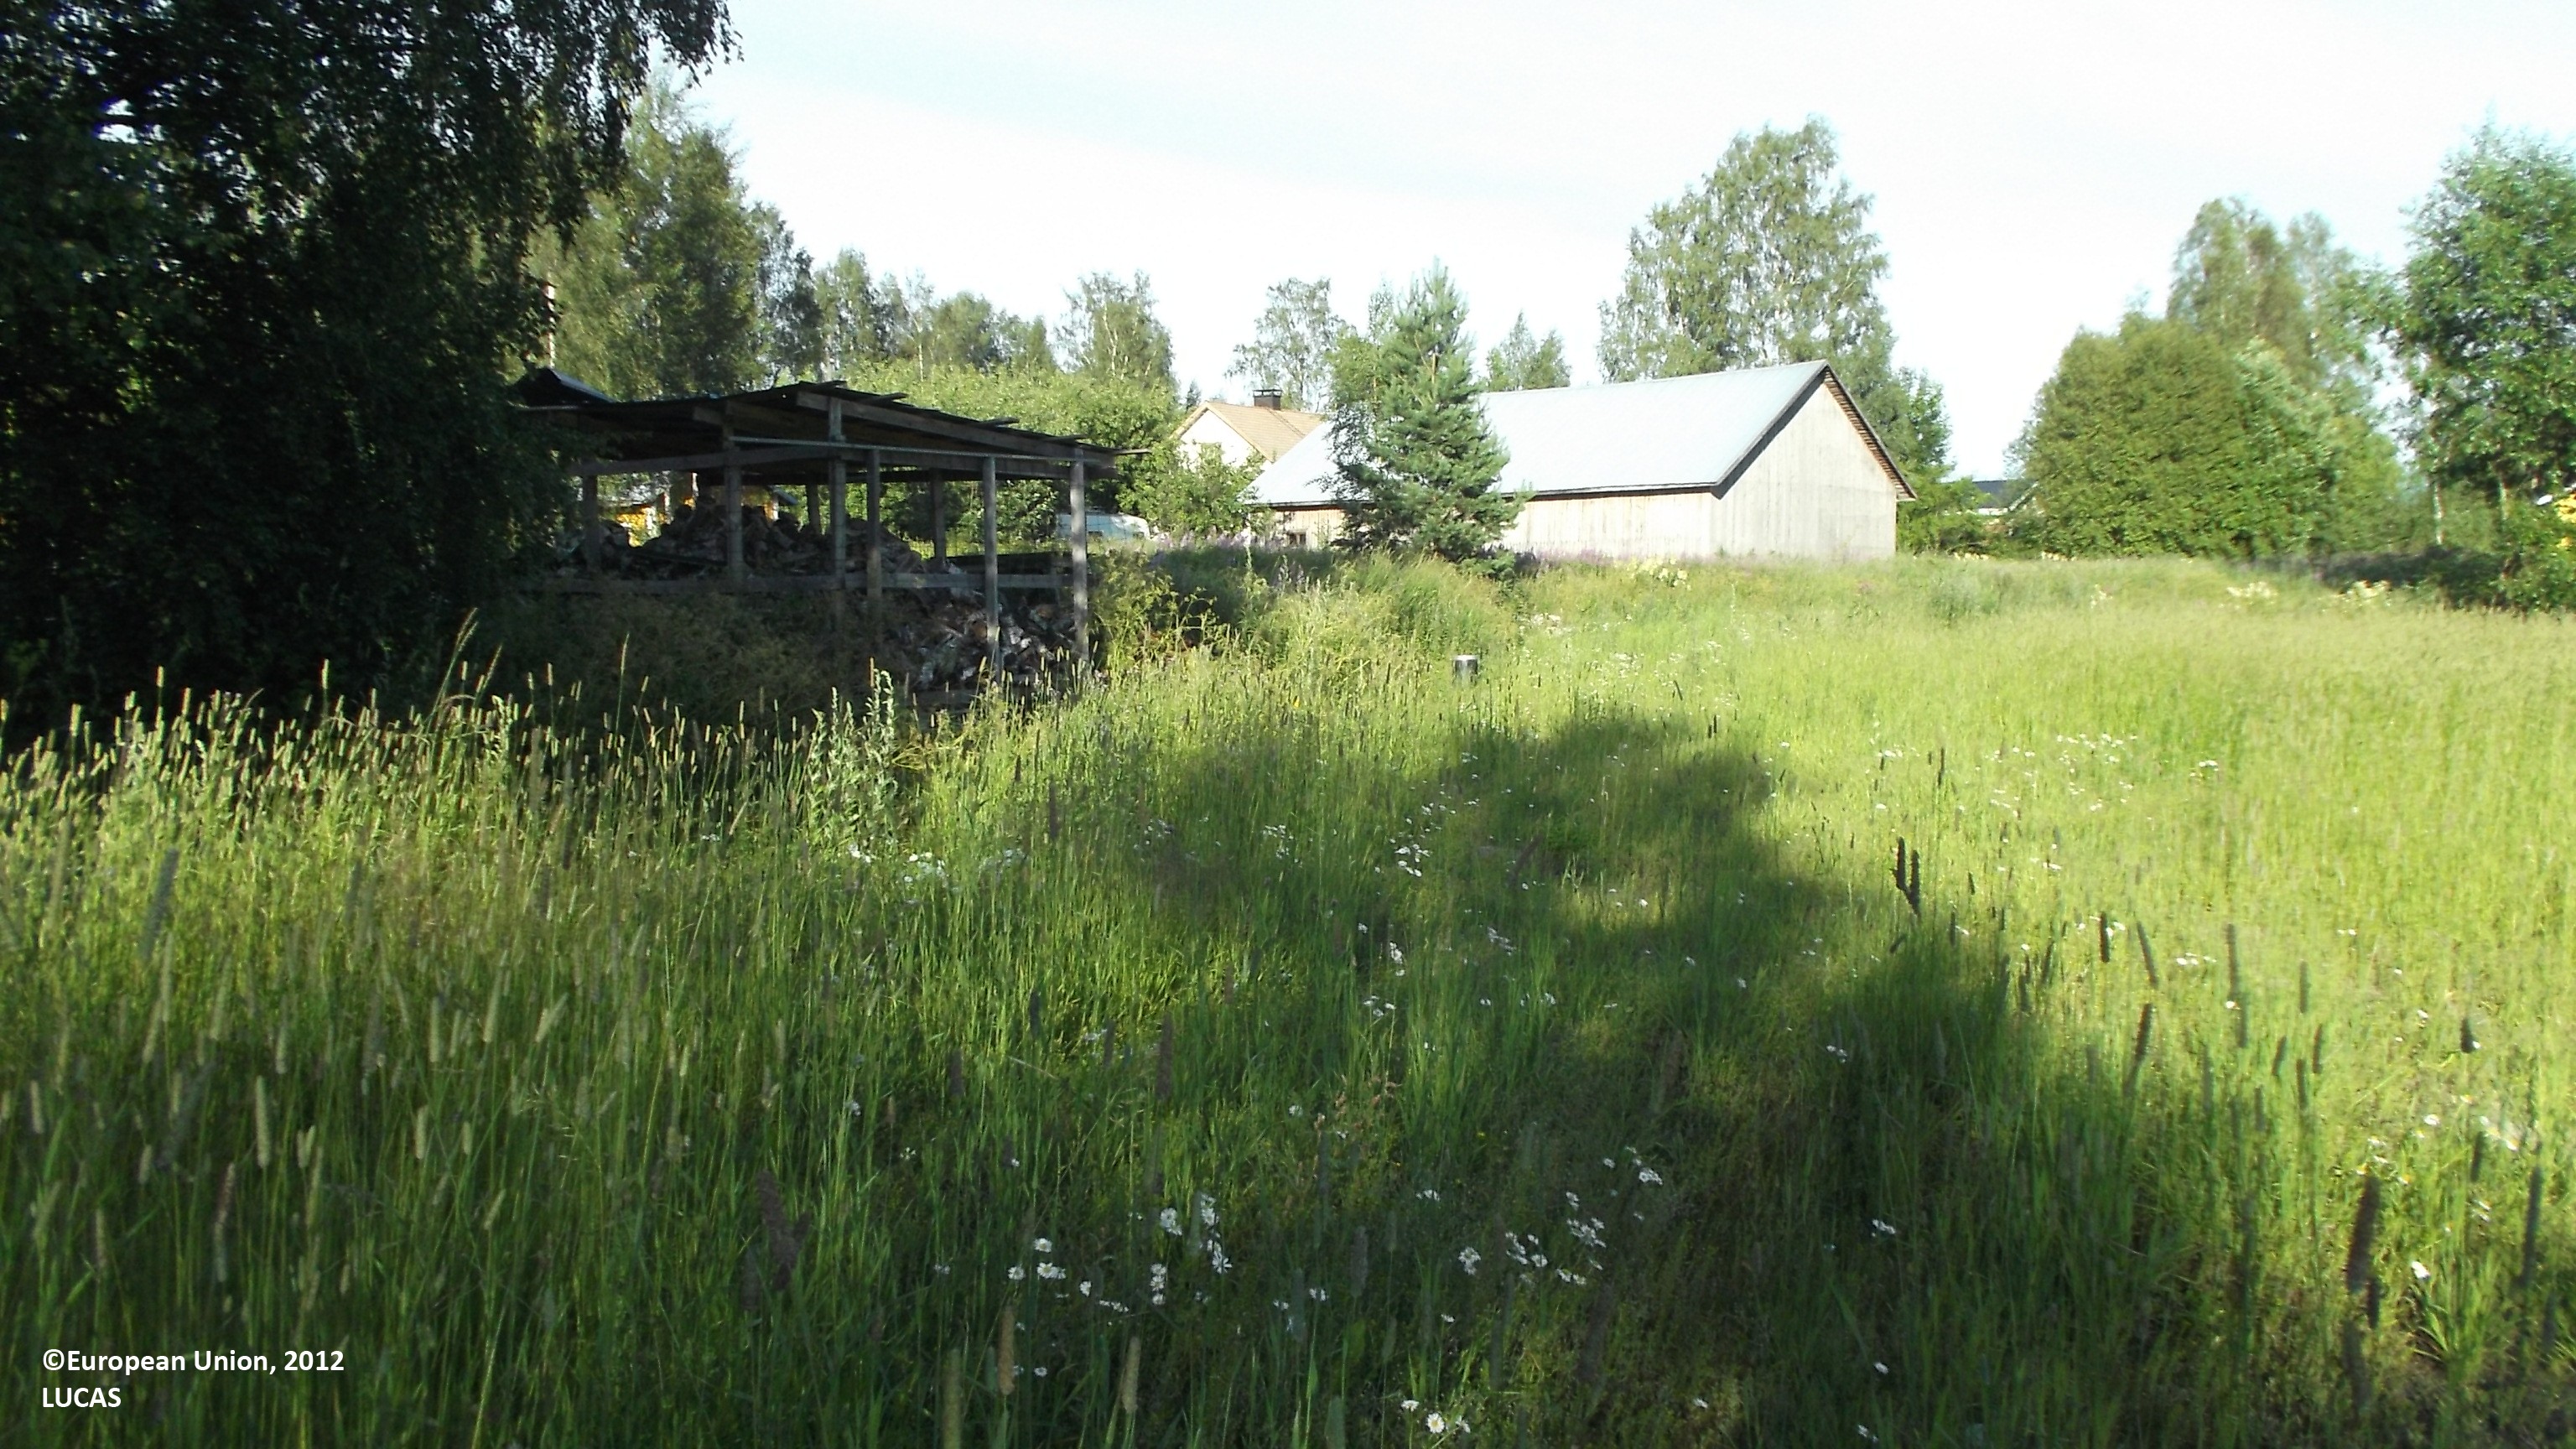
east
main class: Cropland
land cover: Temporary grasslands
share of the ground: 50 - 75 %
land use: Agriculture (excluding fallow land and kitchen gardens)
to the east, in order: Temporary grasslands; Ditches and canals; Single bushes/trees; Artificial constructions in urban areas
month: July
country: FI
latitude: 63.2272
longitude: 23.7388
